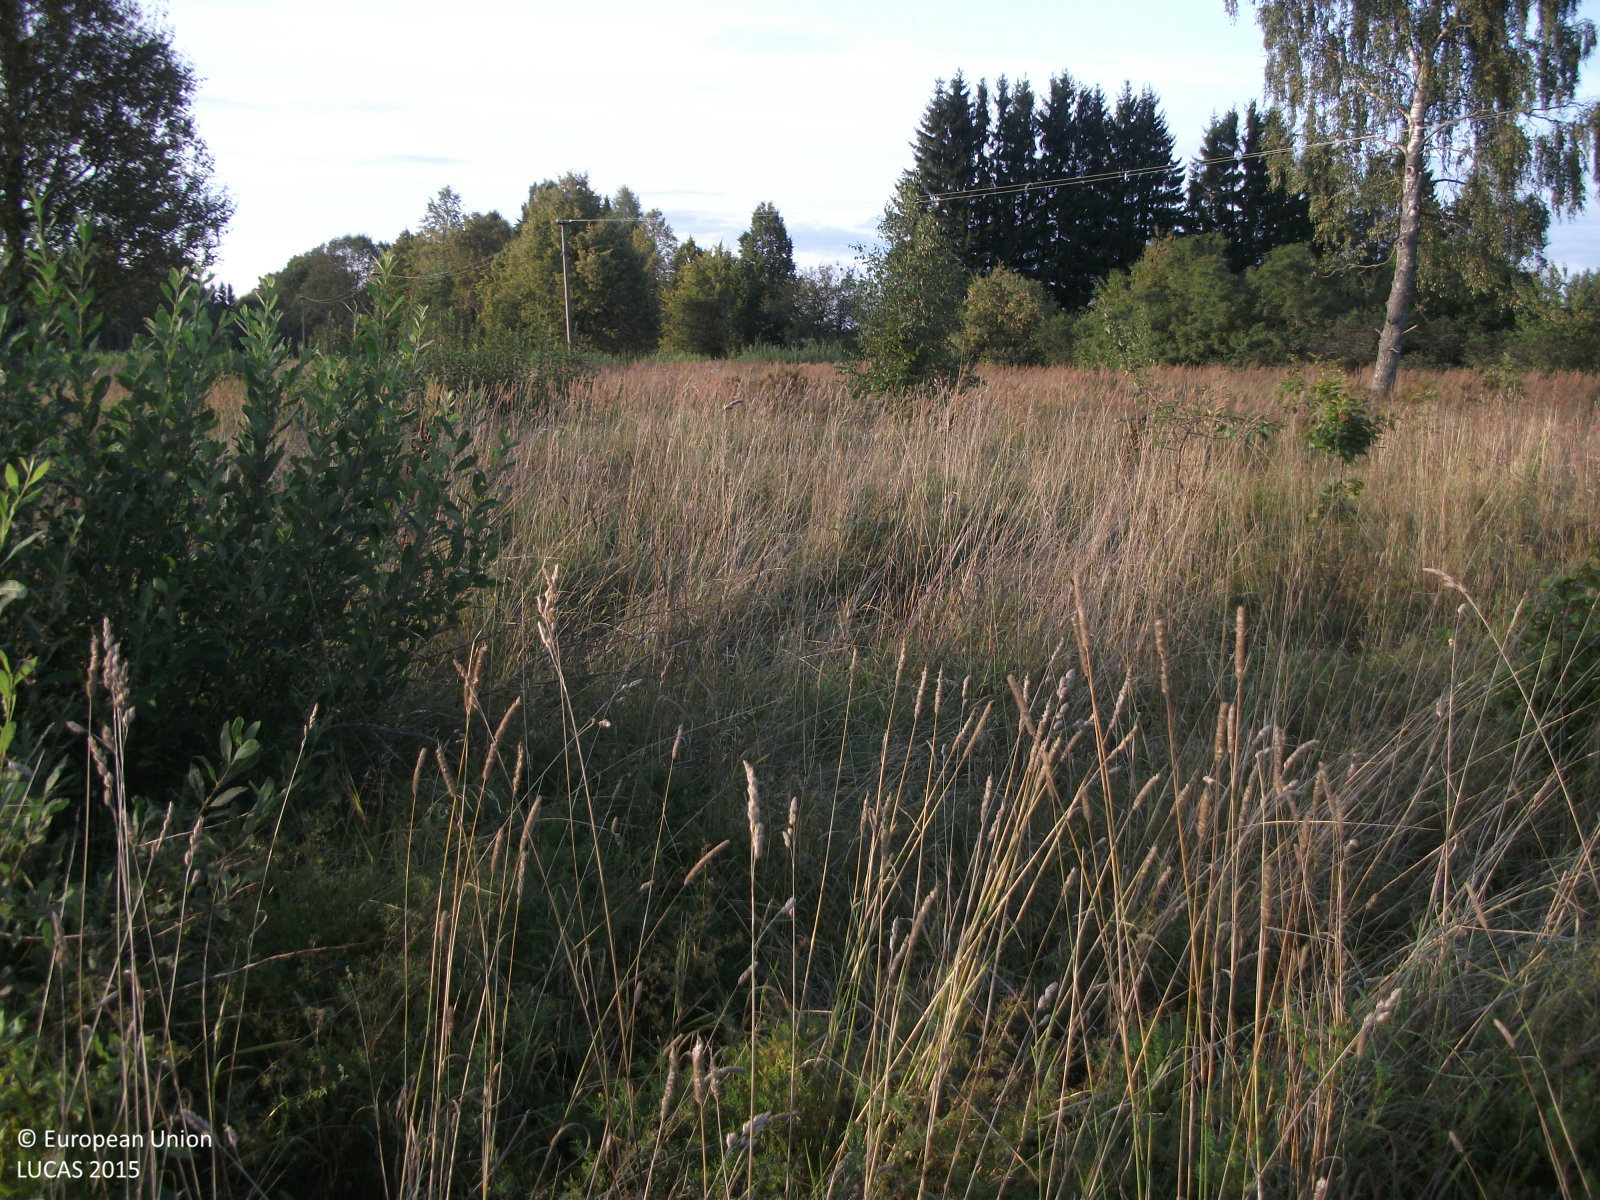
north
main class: Grassland
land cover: Grassland with sparse tree/shrub cover
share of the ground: > 75 %
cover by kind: herbaceous plants 90 %, broadleaved forest trees 5 %, shrubs 5 %
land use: Abandoned areas
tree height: < 5 m
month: September
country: LV
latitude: 57.5714
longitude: 24.5204
